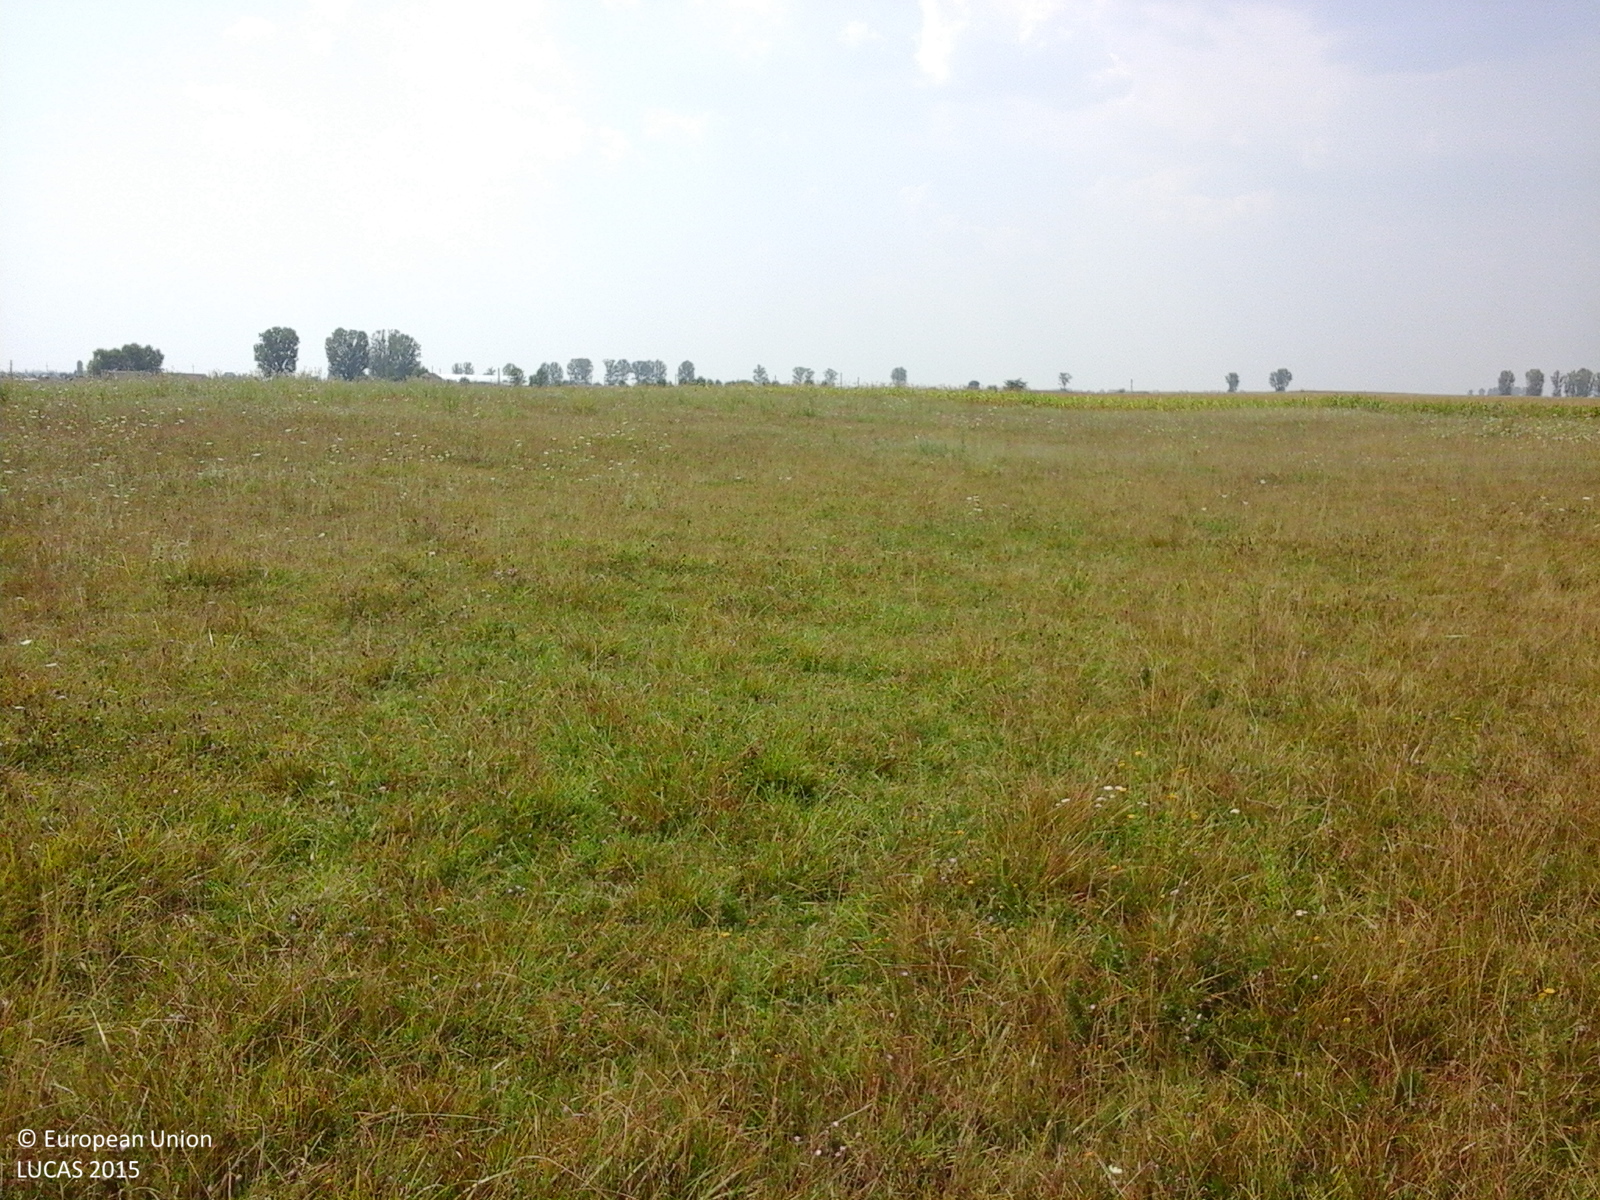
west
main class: Grassland
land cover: Grassland without tree/shrub cover
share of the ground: > 75 %
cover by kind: herbaceous plants 100 %
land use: Agriculture (excluding fallow land and kitchen gardens)
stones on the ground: < 10 %
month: August
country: RO
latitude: 43.9074
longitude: 23.1797
